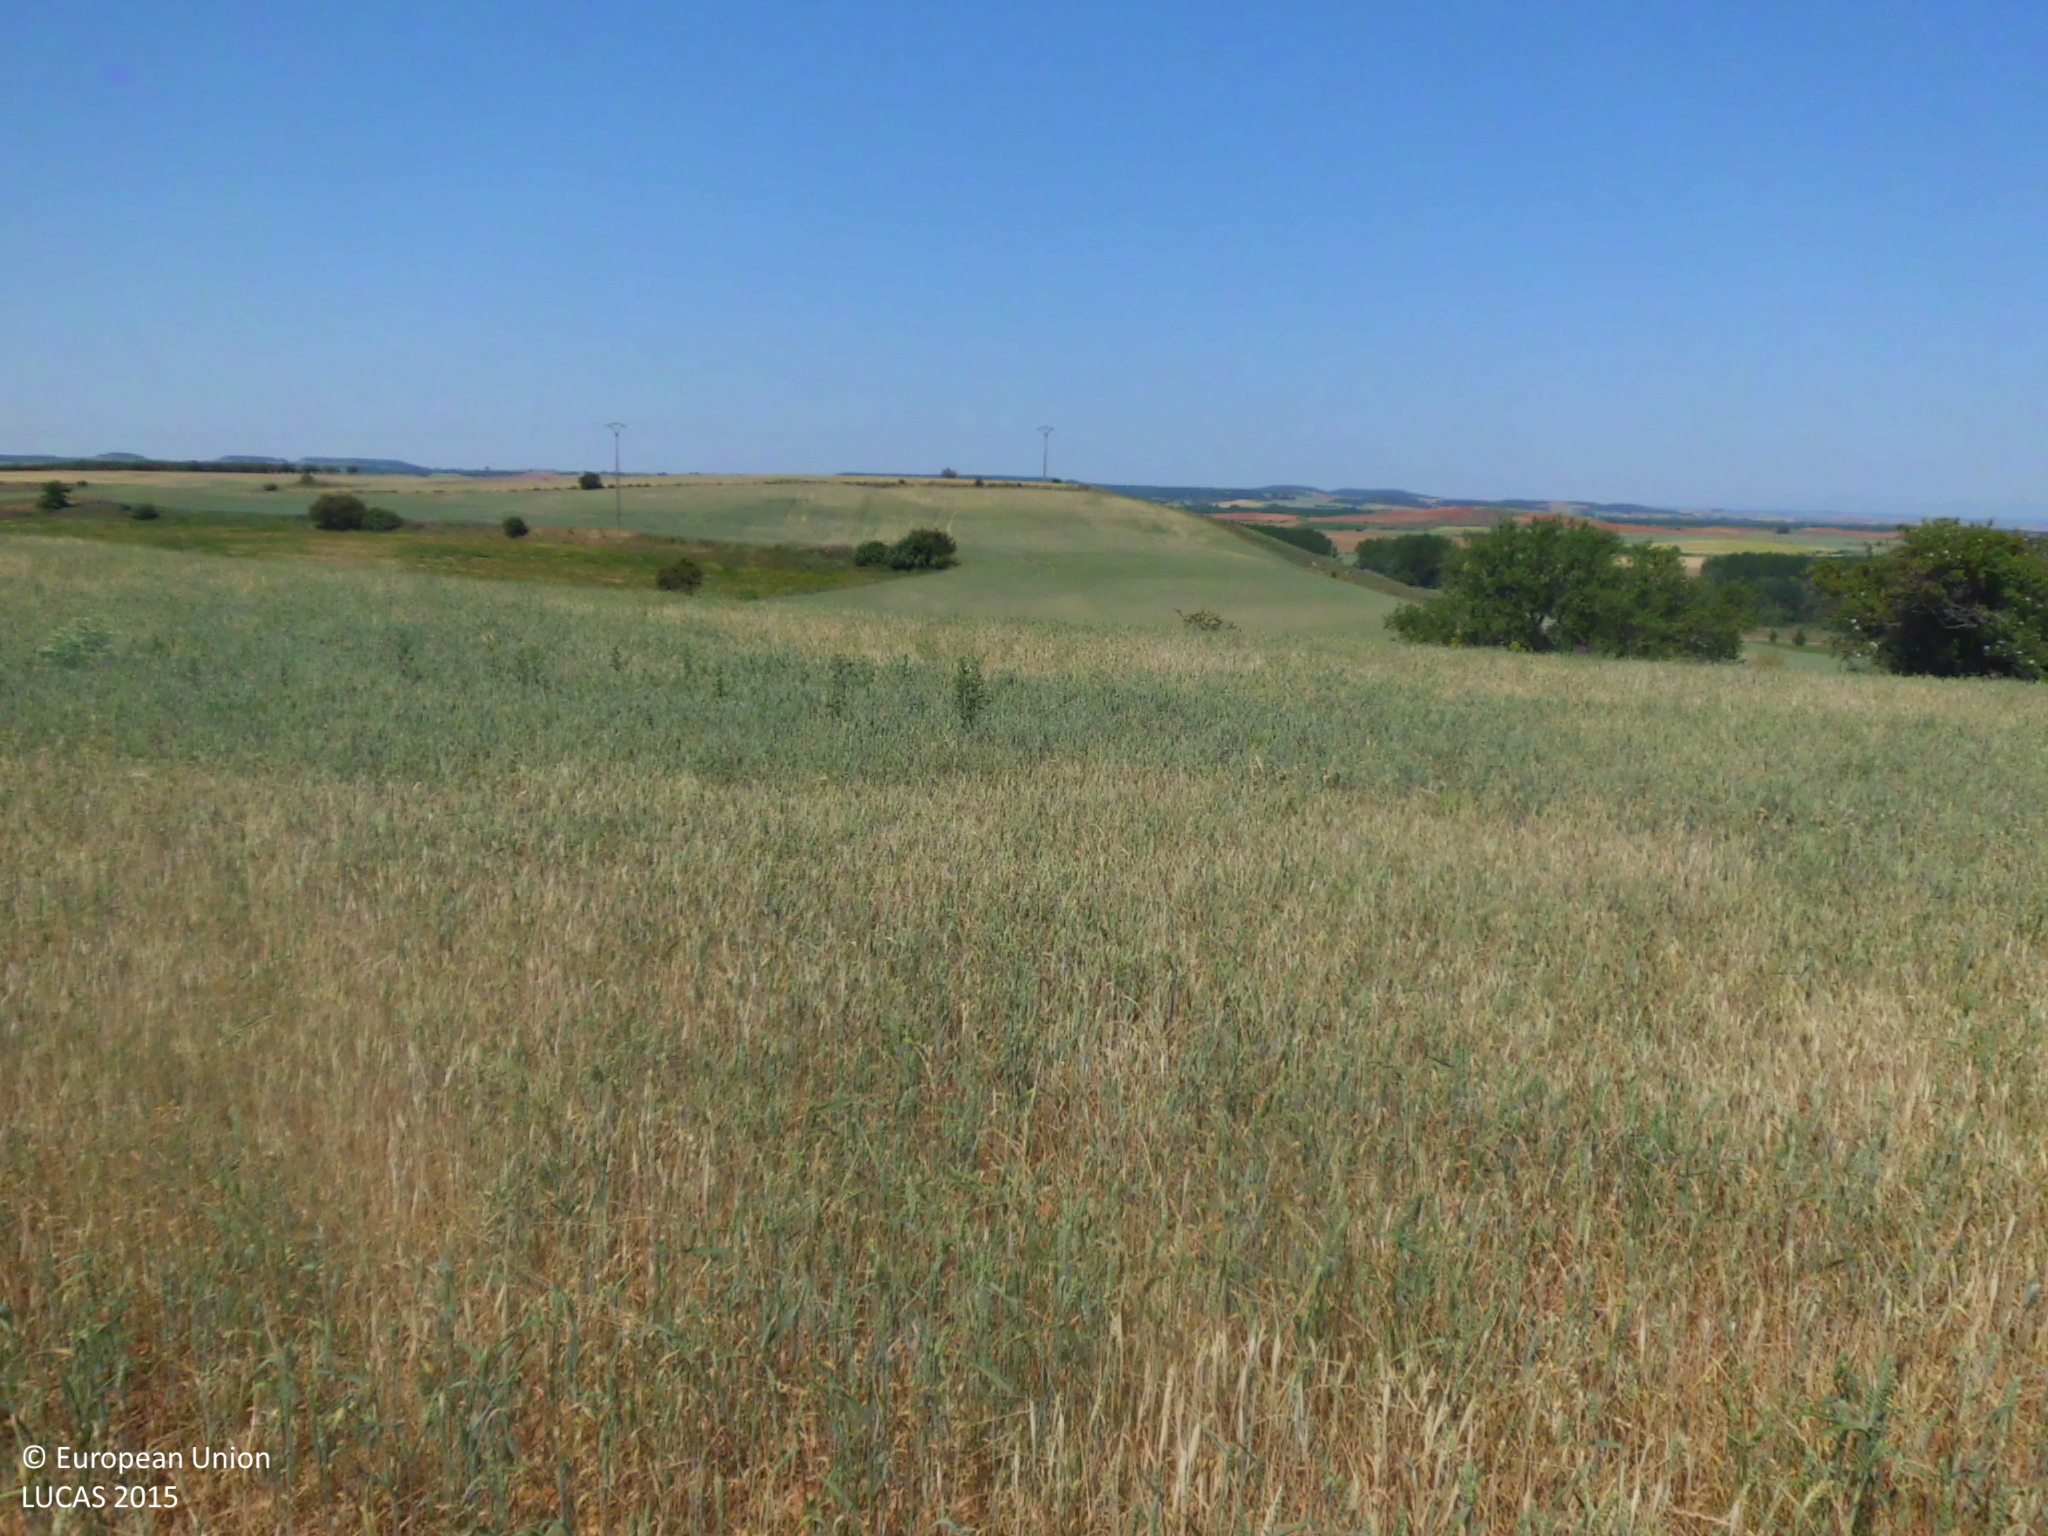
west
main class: Cropland
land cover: Common wheat
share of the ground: > 75 %
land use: Agriculture (excluding fallow land and kitchen gardens)
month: June
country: ES
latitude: 42.5048
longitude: -4.2238
